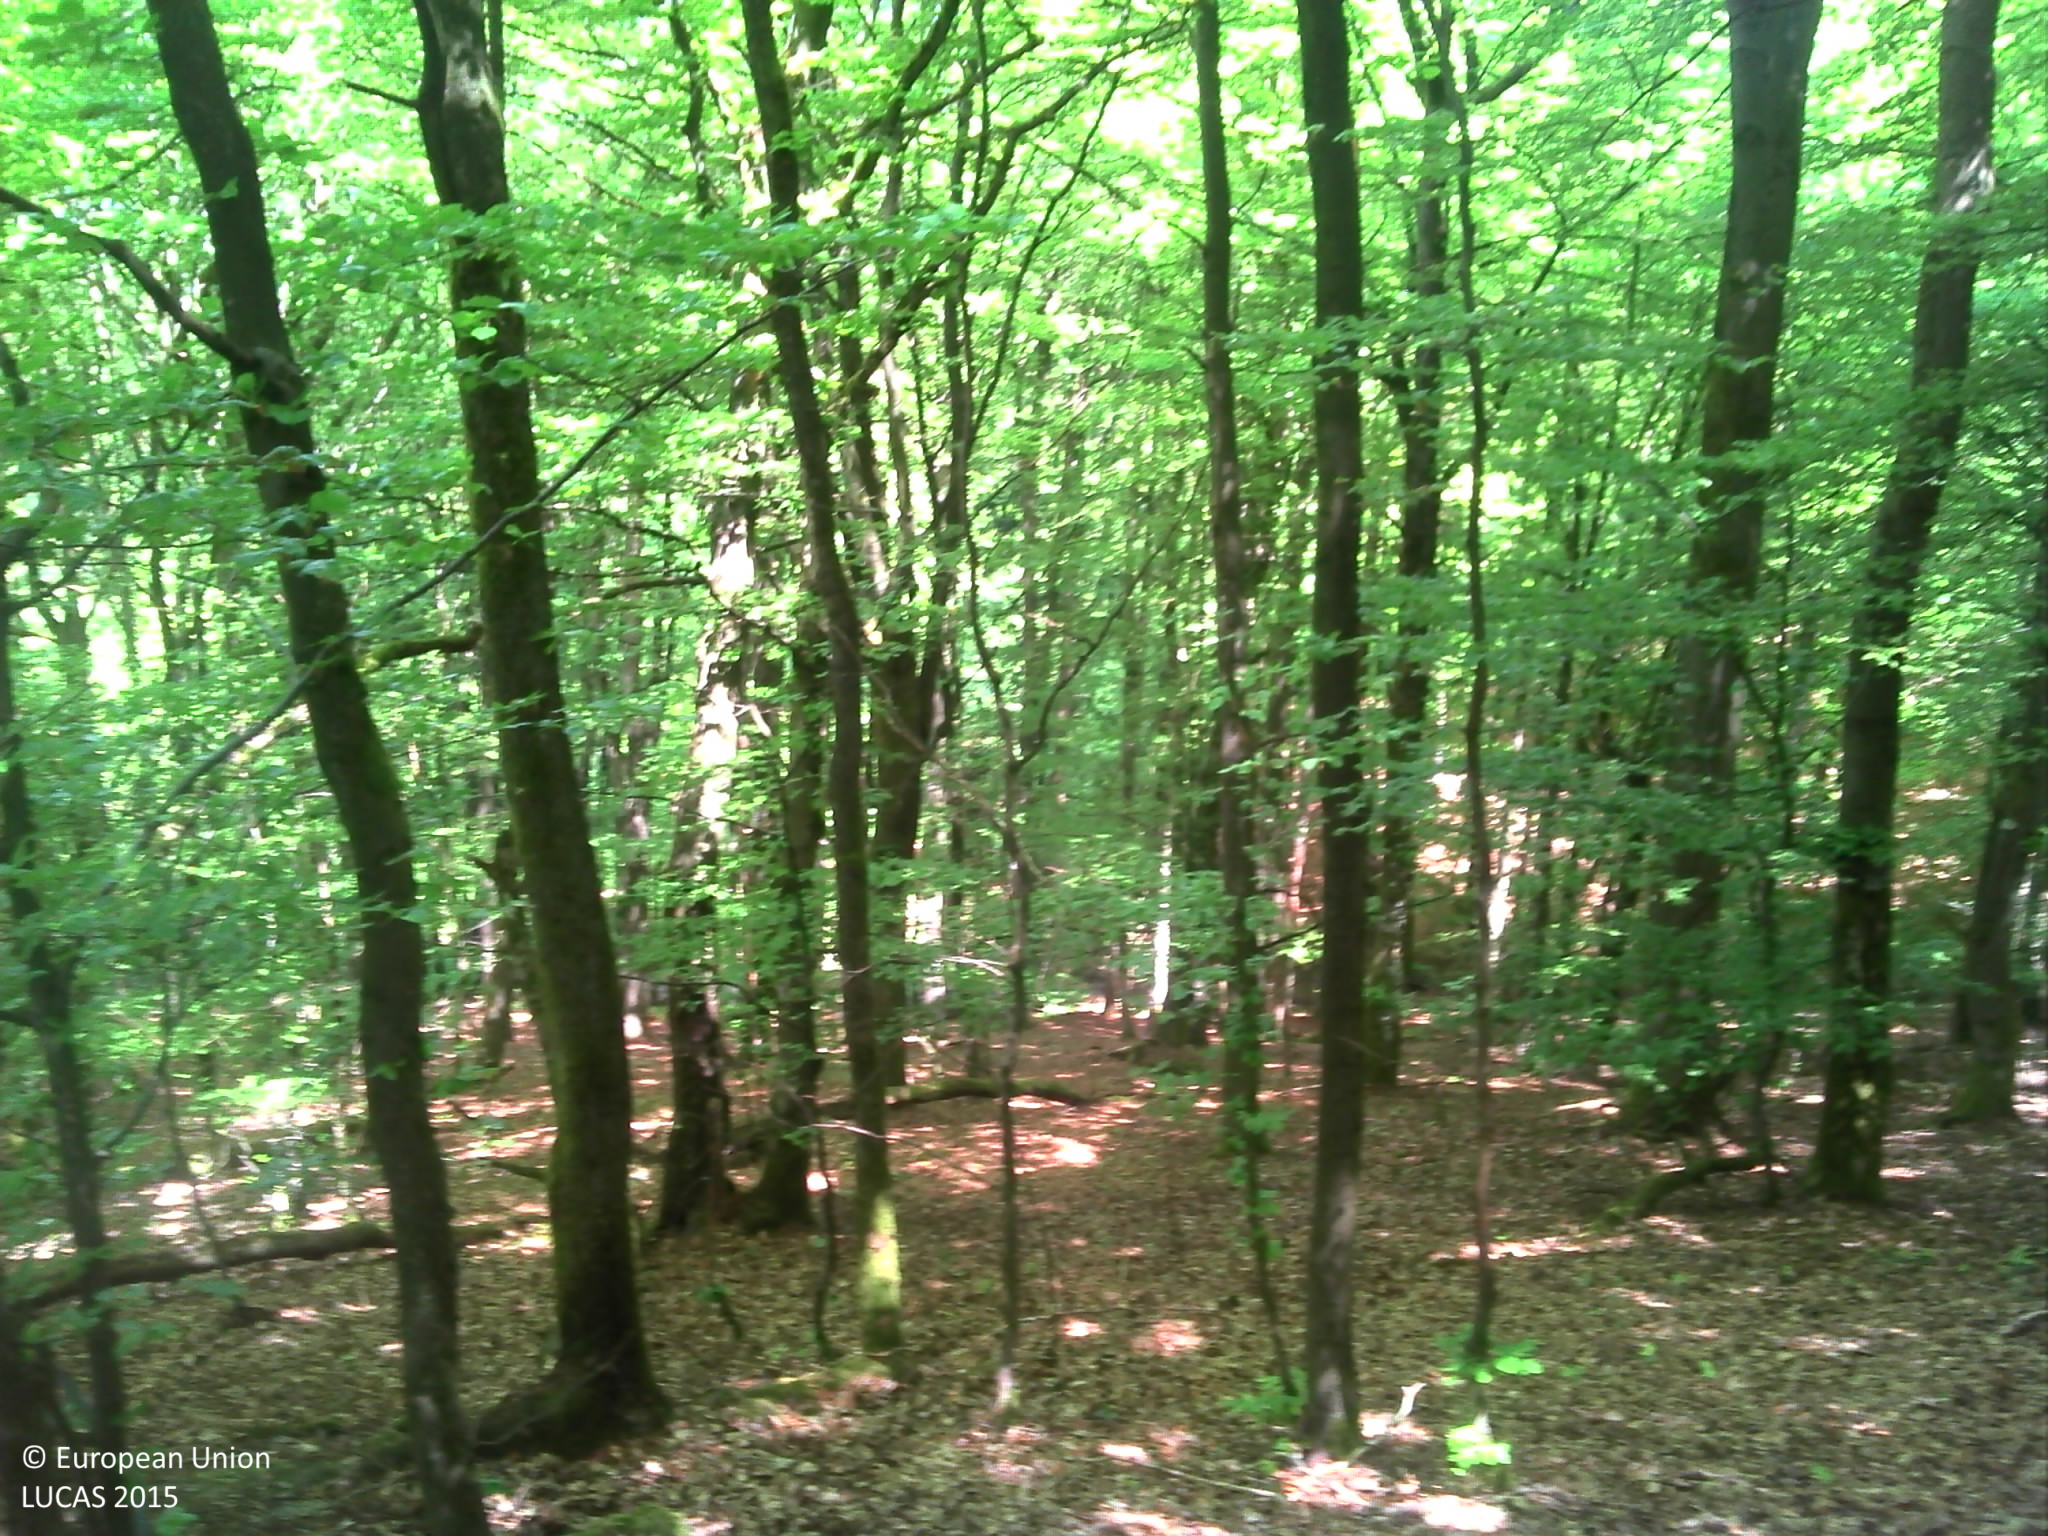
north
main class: Woodland
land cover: Broadleaved woodland
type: acidophilous oak and oak-birch forest
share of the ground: > 75 %
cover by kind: broadleaved forest trees 100 %
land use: Forestry
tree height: > 5 m
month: May
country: LU
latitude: 49.8583
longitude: 5.8955
